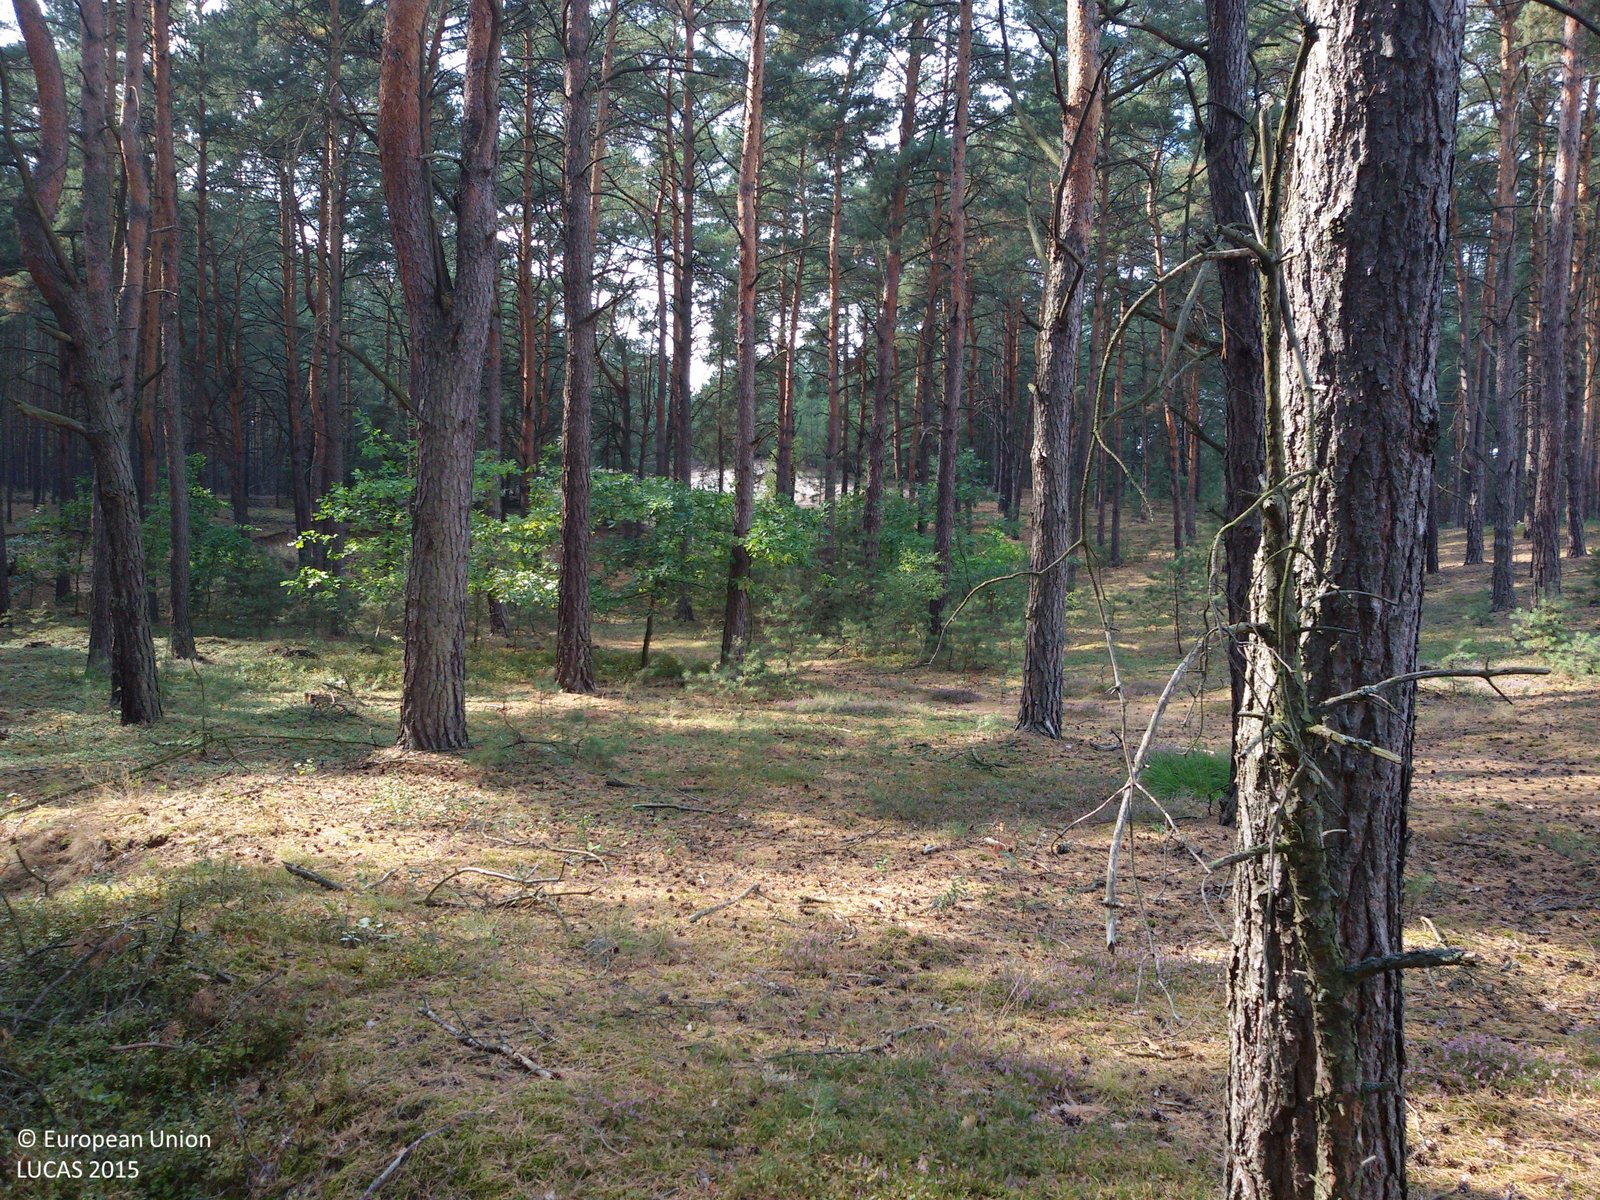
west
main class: Woodland
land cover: Pine dominated coniferous woodland
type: hemiboreal forest and nemoral coniferous forest and mixed broadleaved-coniferous forest
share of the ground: > 75 %
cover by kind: coniferous forest trees 70 %, broadleaved forest trees 10 %, shrubs 10 %, herbaceous plants 10 %
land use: Forestry
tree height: > 5 m
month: September
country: PL
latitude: 51.9682
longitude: 17.9189
